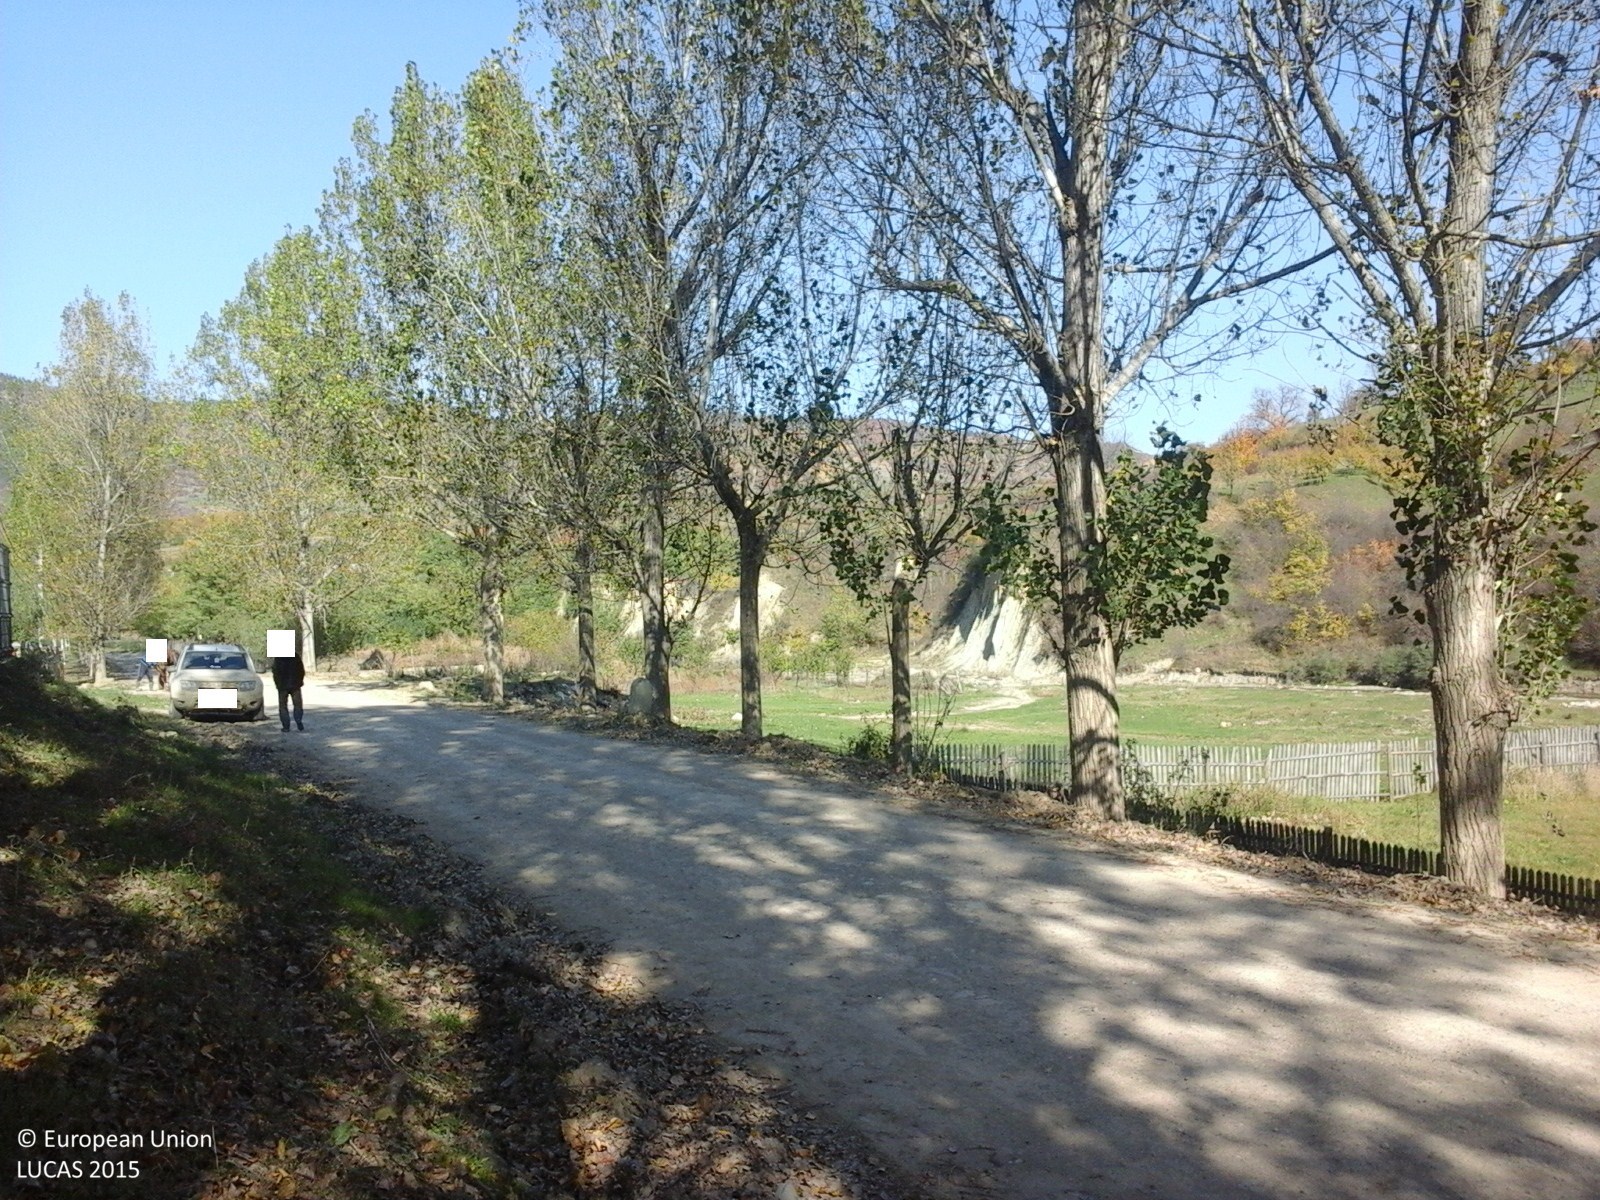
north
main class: Grassland
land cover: Grassland without tree/shrub cover
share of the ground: > 75 %
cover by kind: herbaceous plants 100 %
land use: Residential
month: October
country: RO
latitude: 45.4223
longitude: 26.5222
